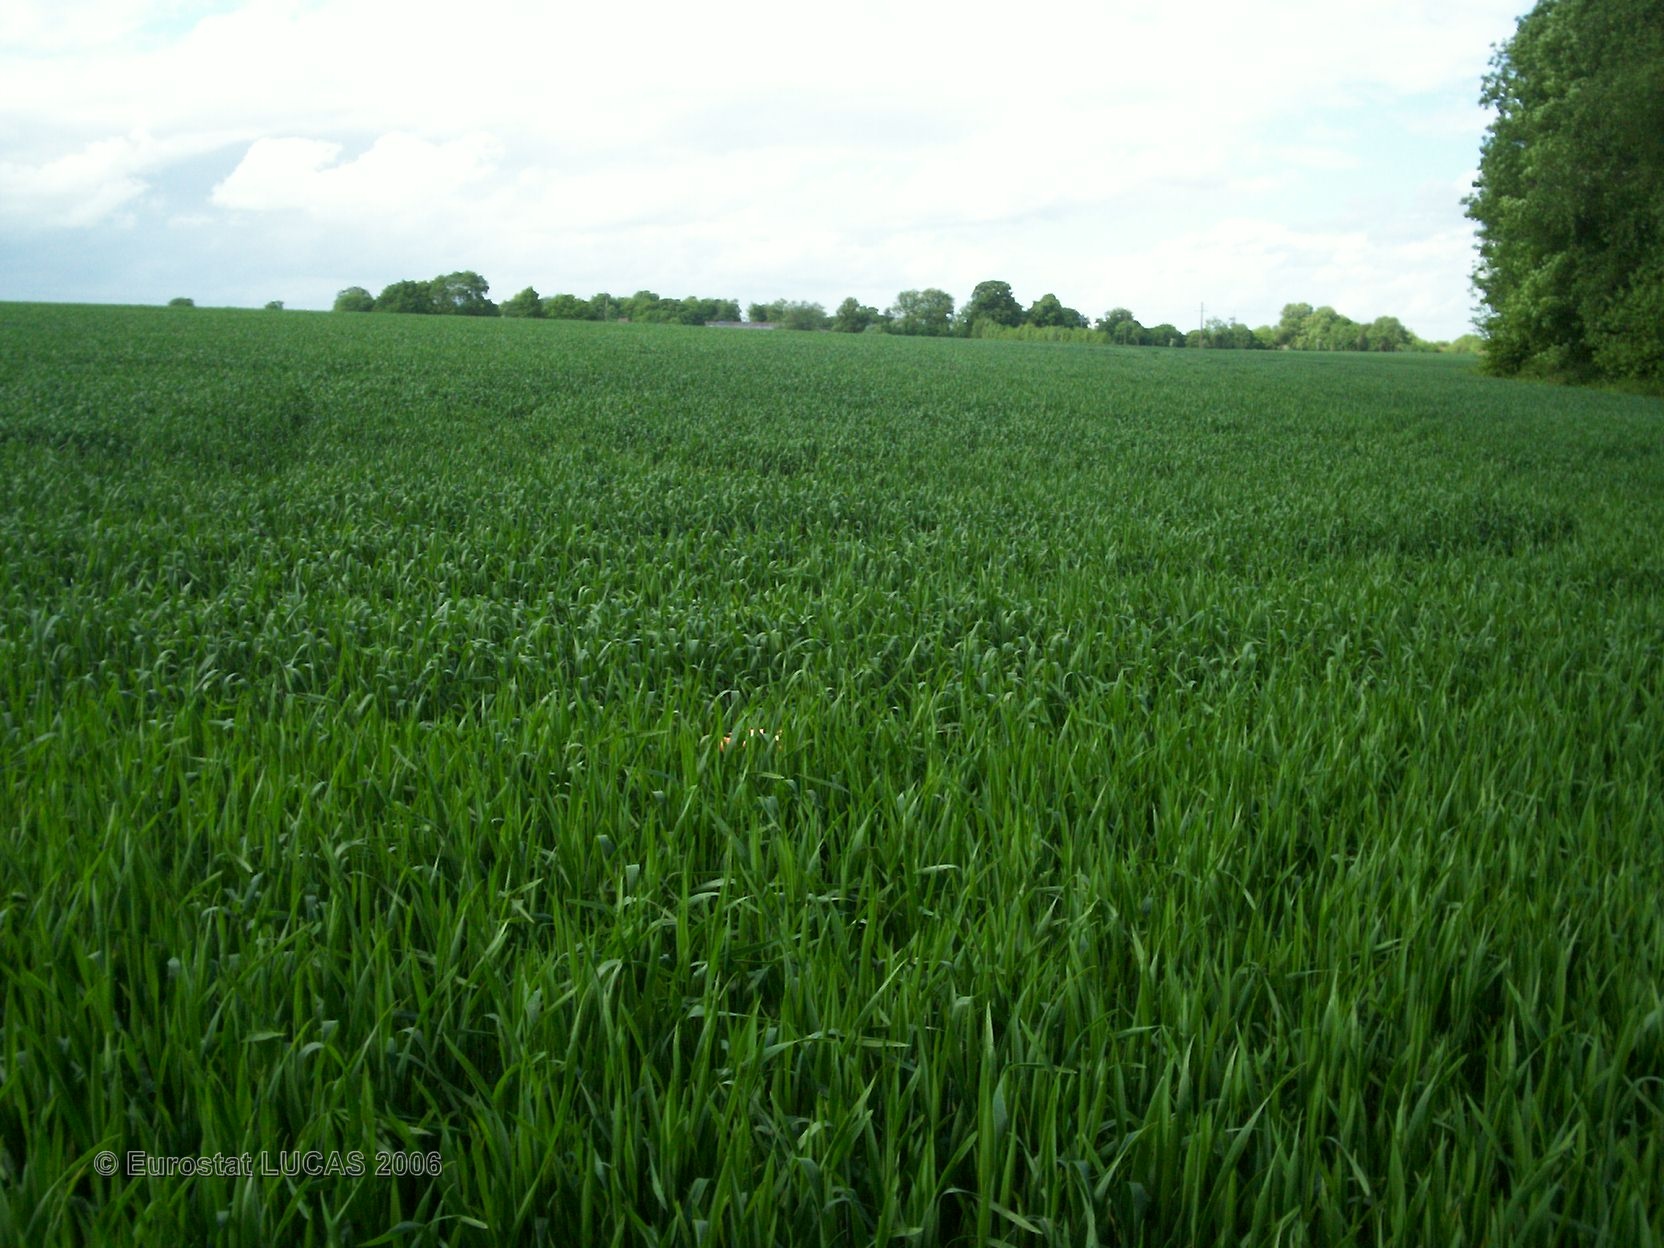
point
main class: Cropland
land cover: Common wheat
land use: Agriculture (excluding fallow land and kitchen gardens)
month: May
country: FR
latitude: 49.3891
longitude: 0.5089
